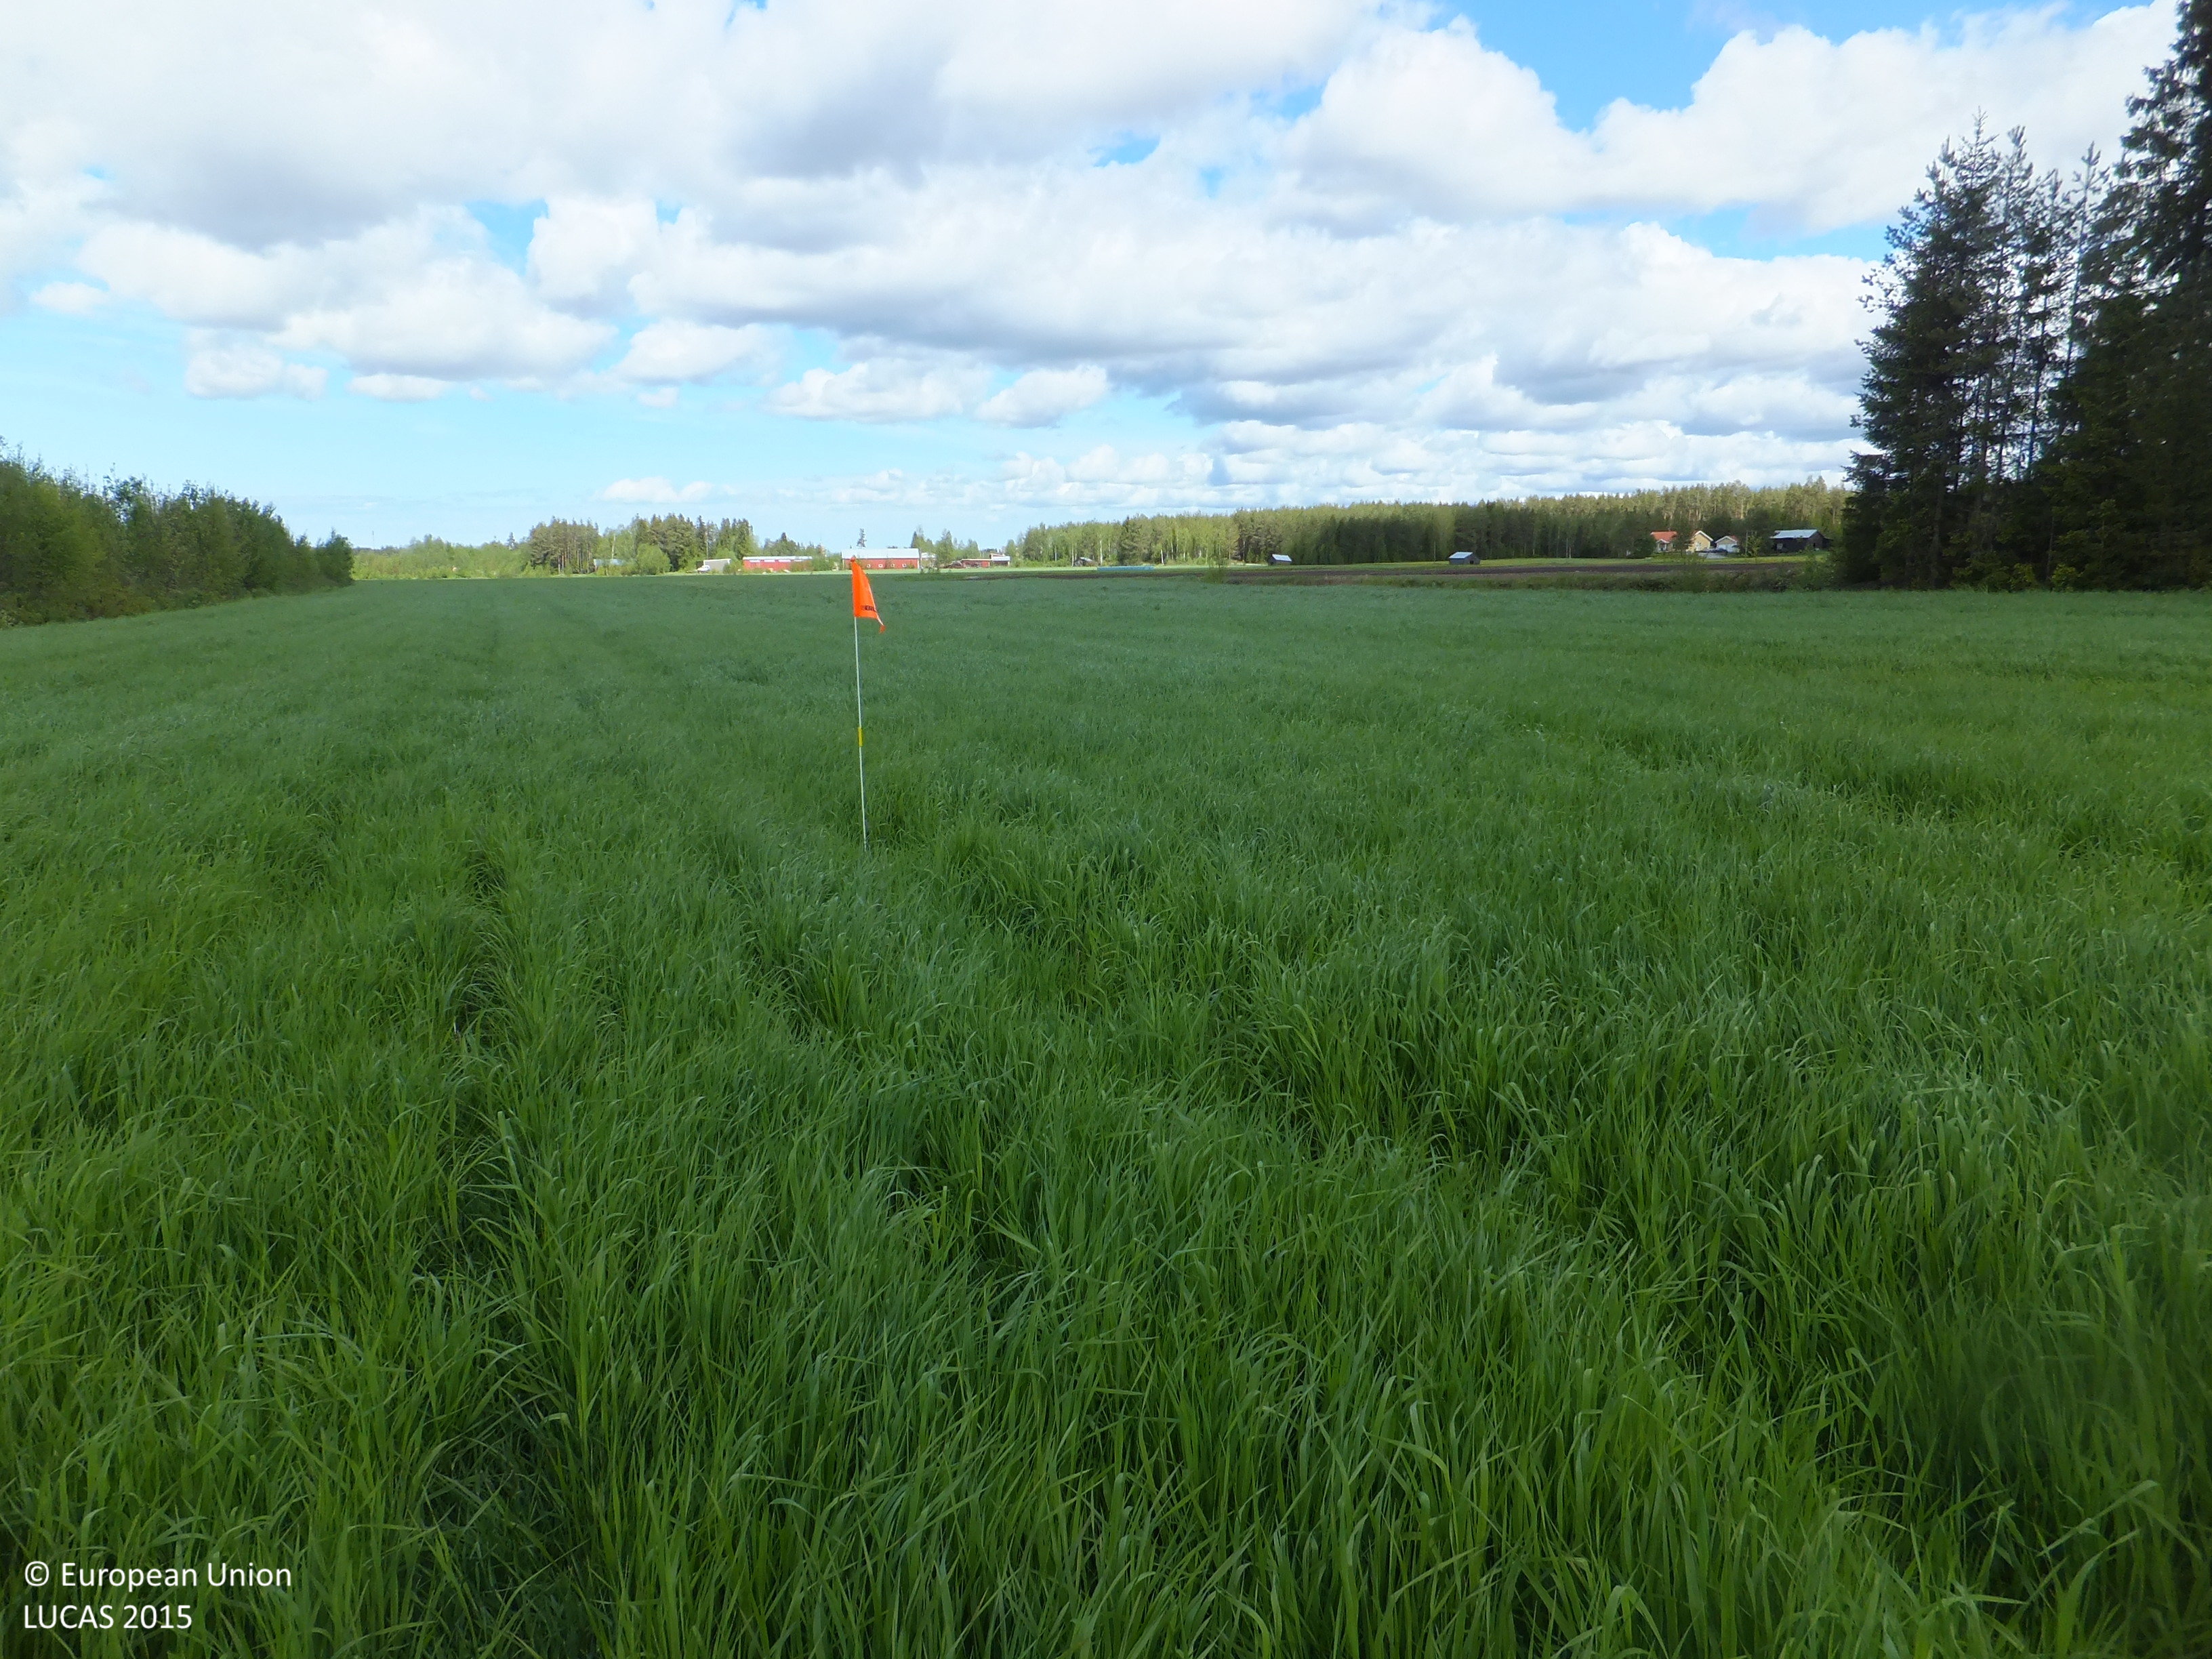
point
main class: Cropland
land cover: Temporary grasslands
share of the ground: > 75 %
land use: Agriculture (excluding fallow land and kitchen gardens)
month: June
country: FI
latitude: 63.5815
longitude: 23.0478
